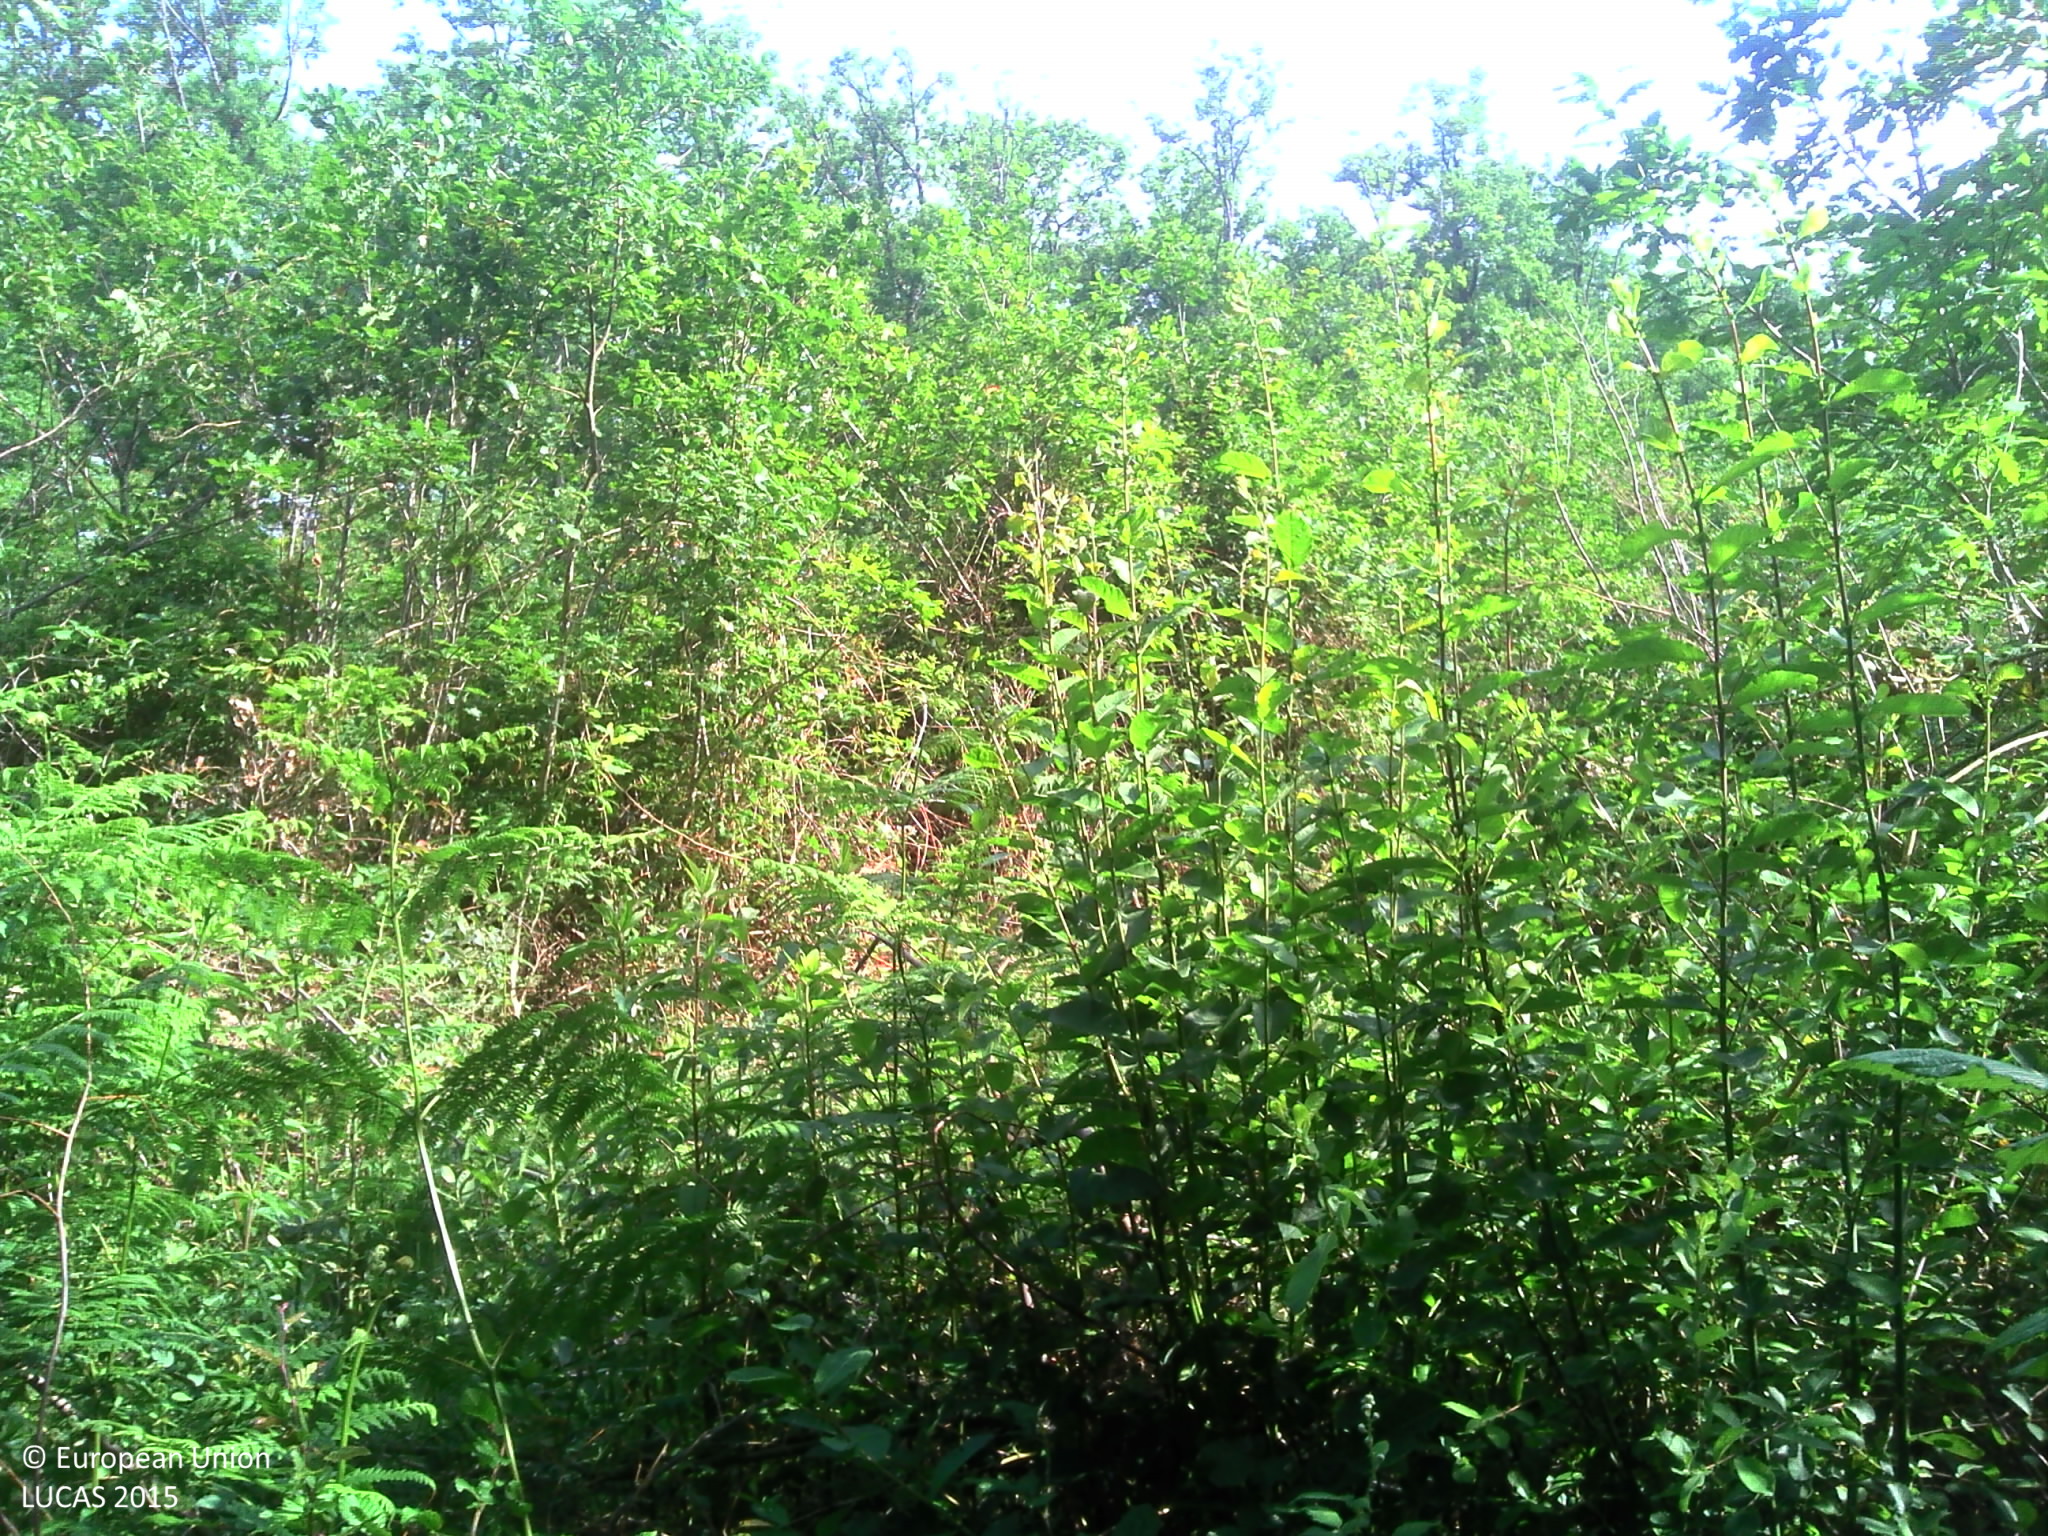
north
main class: Woodland
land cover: Broadleaved woodland
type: mesophytic deciduous forest
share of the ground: > 75 %
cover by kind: herbaceous plants 70 %, broadleaved forest trees 30 %
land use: Forestry
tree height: > 5 m
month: June
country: FR
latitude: 47.5560
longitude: 1.3335
